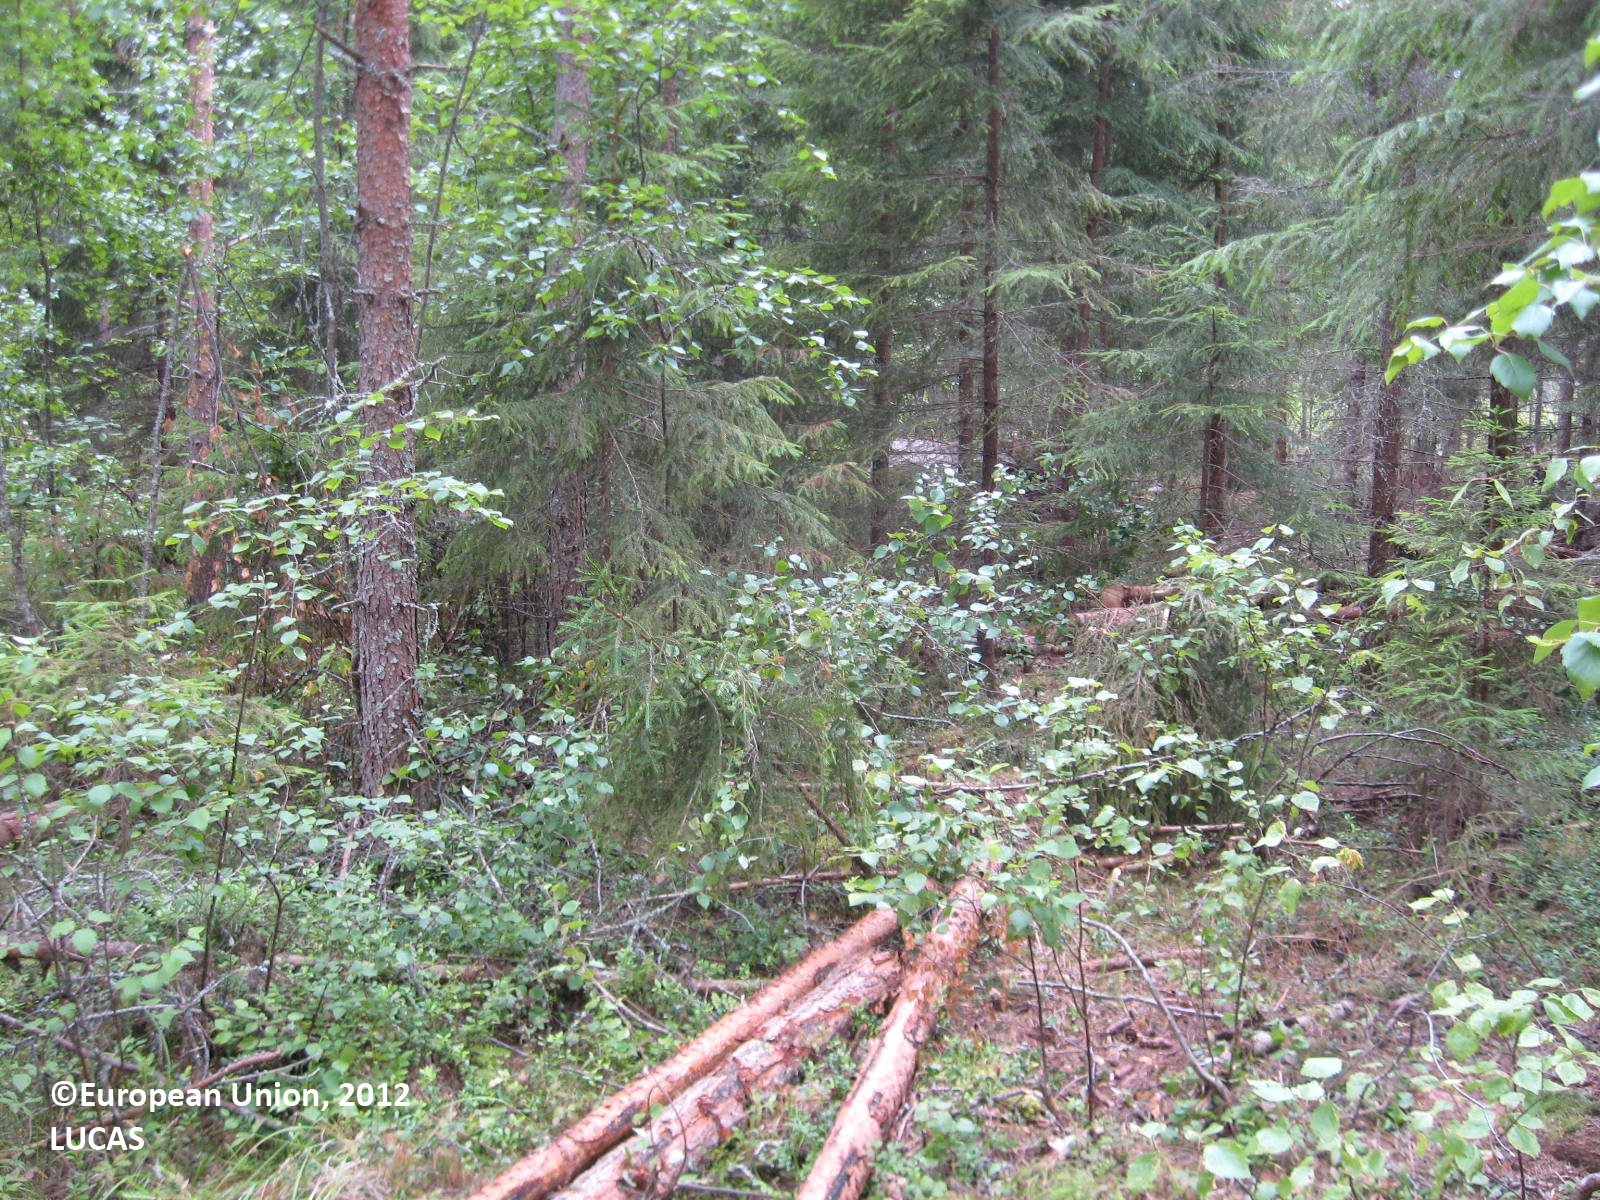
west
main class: Woodland
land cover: Other coniferous woodland
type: boreal forest
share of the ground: > 75 %
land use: Forestry
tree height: > 5 m
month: July
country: FI
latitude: 61.9155
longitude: 21.4912
